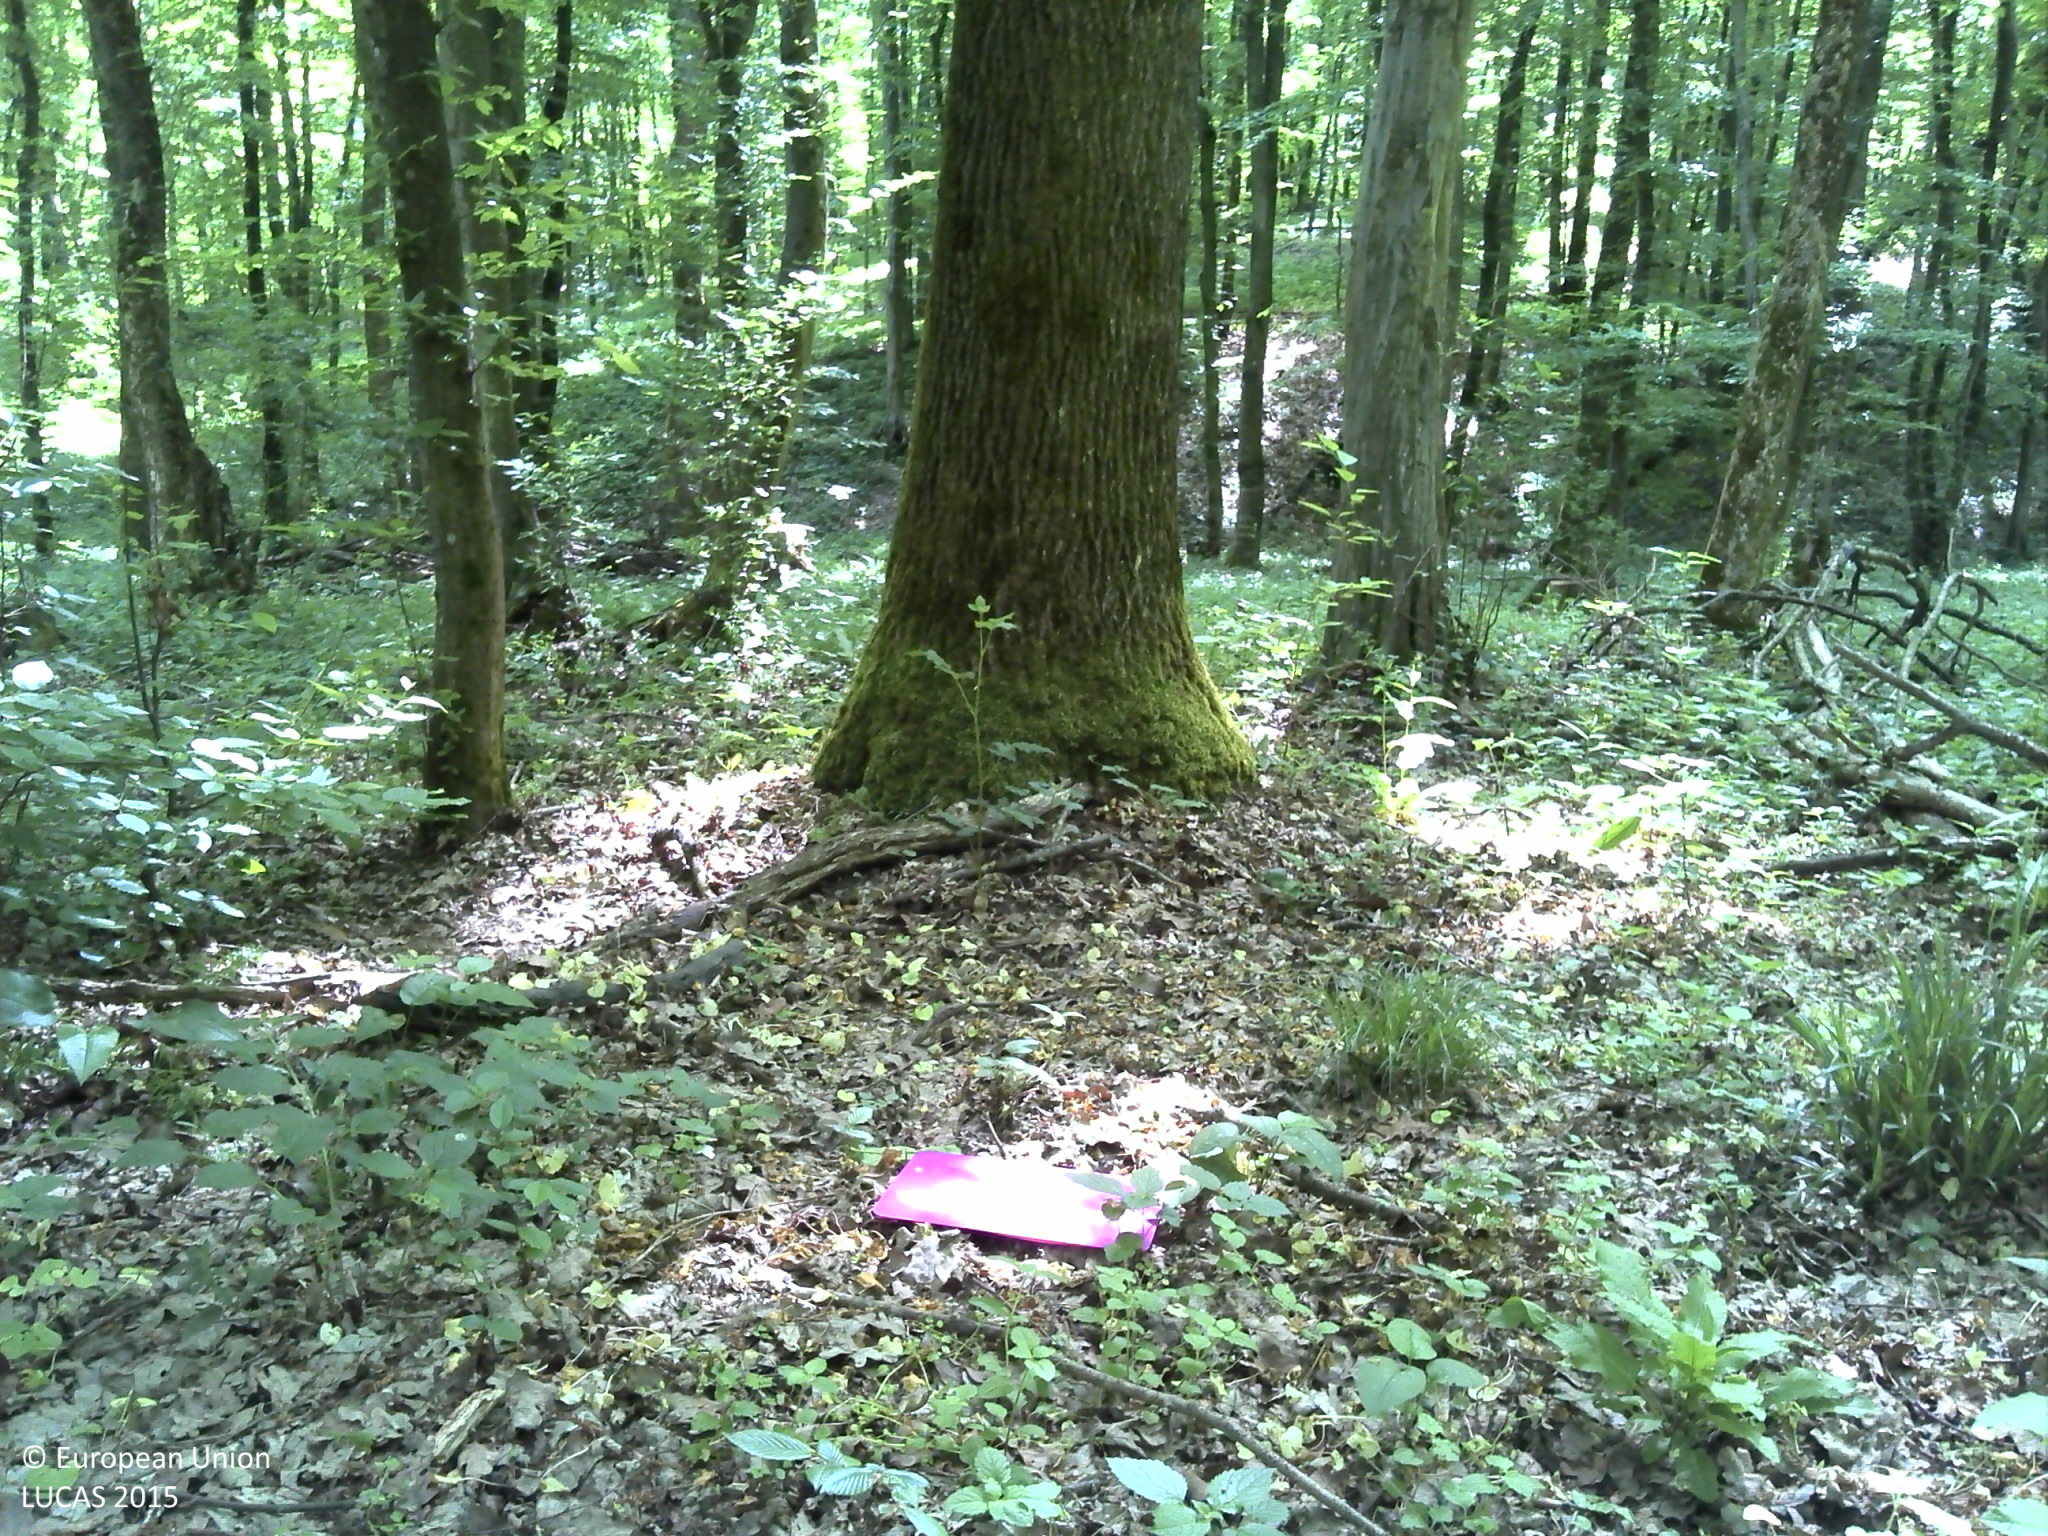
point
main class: Woodland
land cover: Broadleaved woodland
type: acidophilous oak and oak-birch forest
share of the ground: > 75 %
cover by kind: broadleaved forest trees 100 %
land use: Forestry
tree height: > 5 m
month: May
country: HR
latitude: 45.4207
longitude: 18.1962
